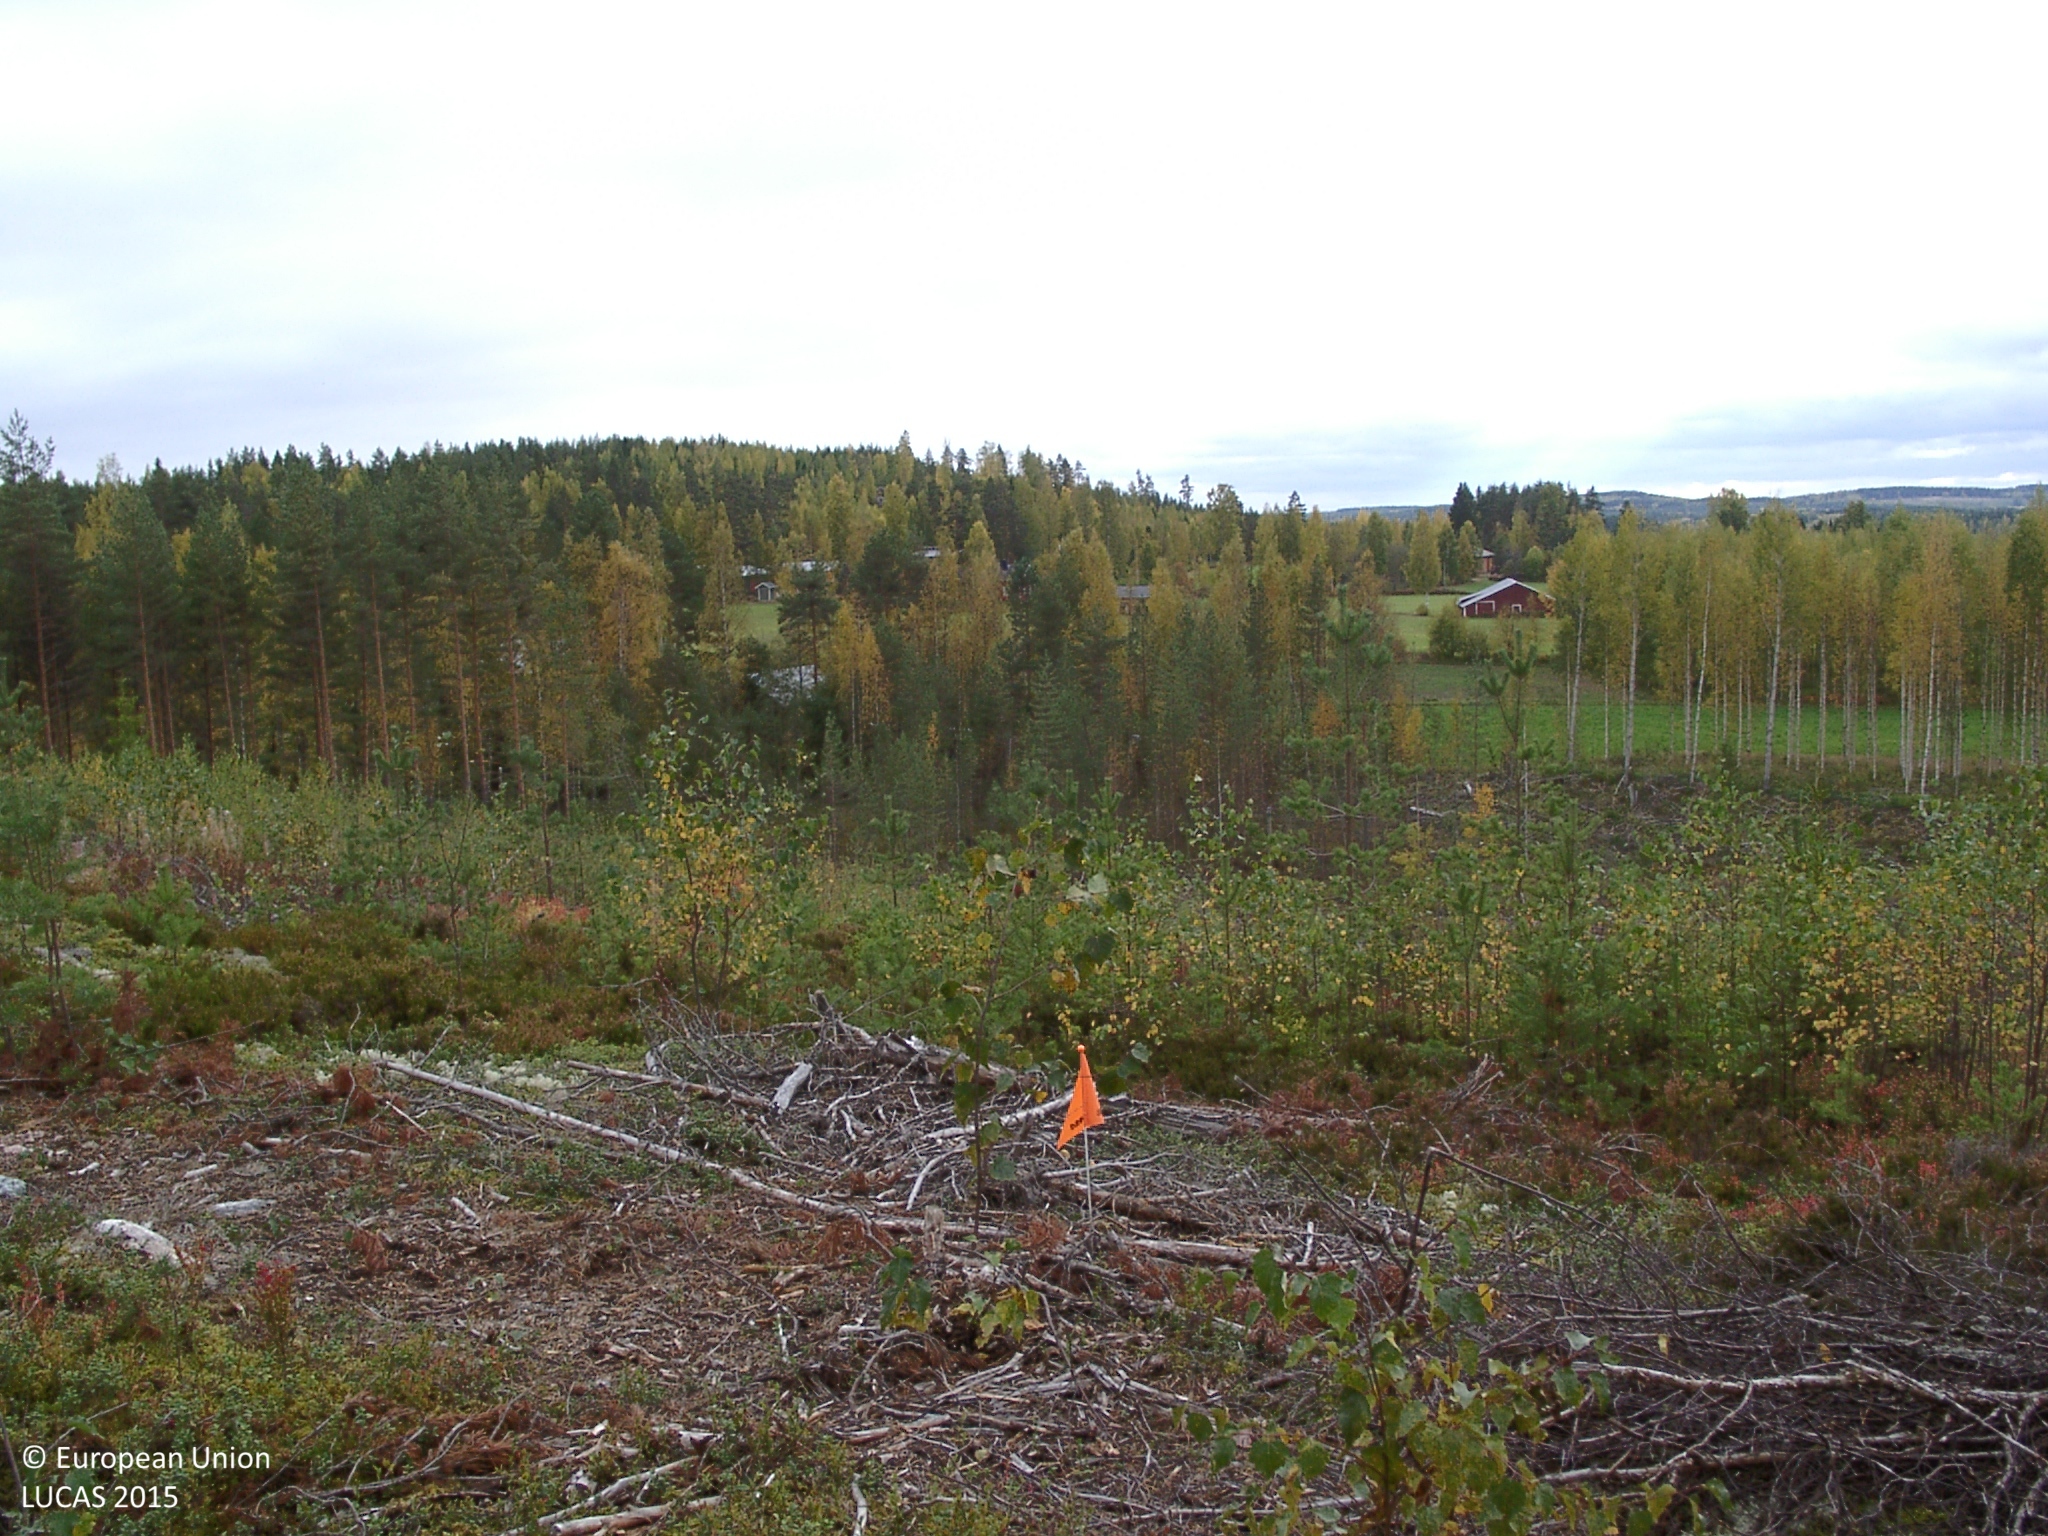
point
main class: Shrubland
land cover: Shrubland with sparse tree cover
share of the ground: 50 - 75 %
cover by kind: shrubs 60 %, lichens and mosses 30 %, coniferous forest trees 5 %
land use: Forestry
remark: Clear cut
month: September
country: FI
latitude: 62.6019
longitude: 25.4393
